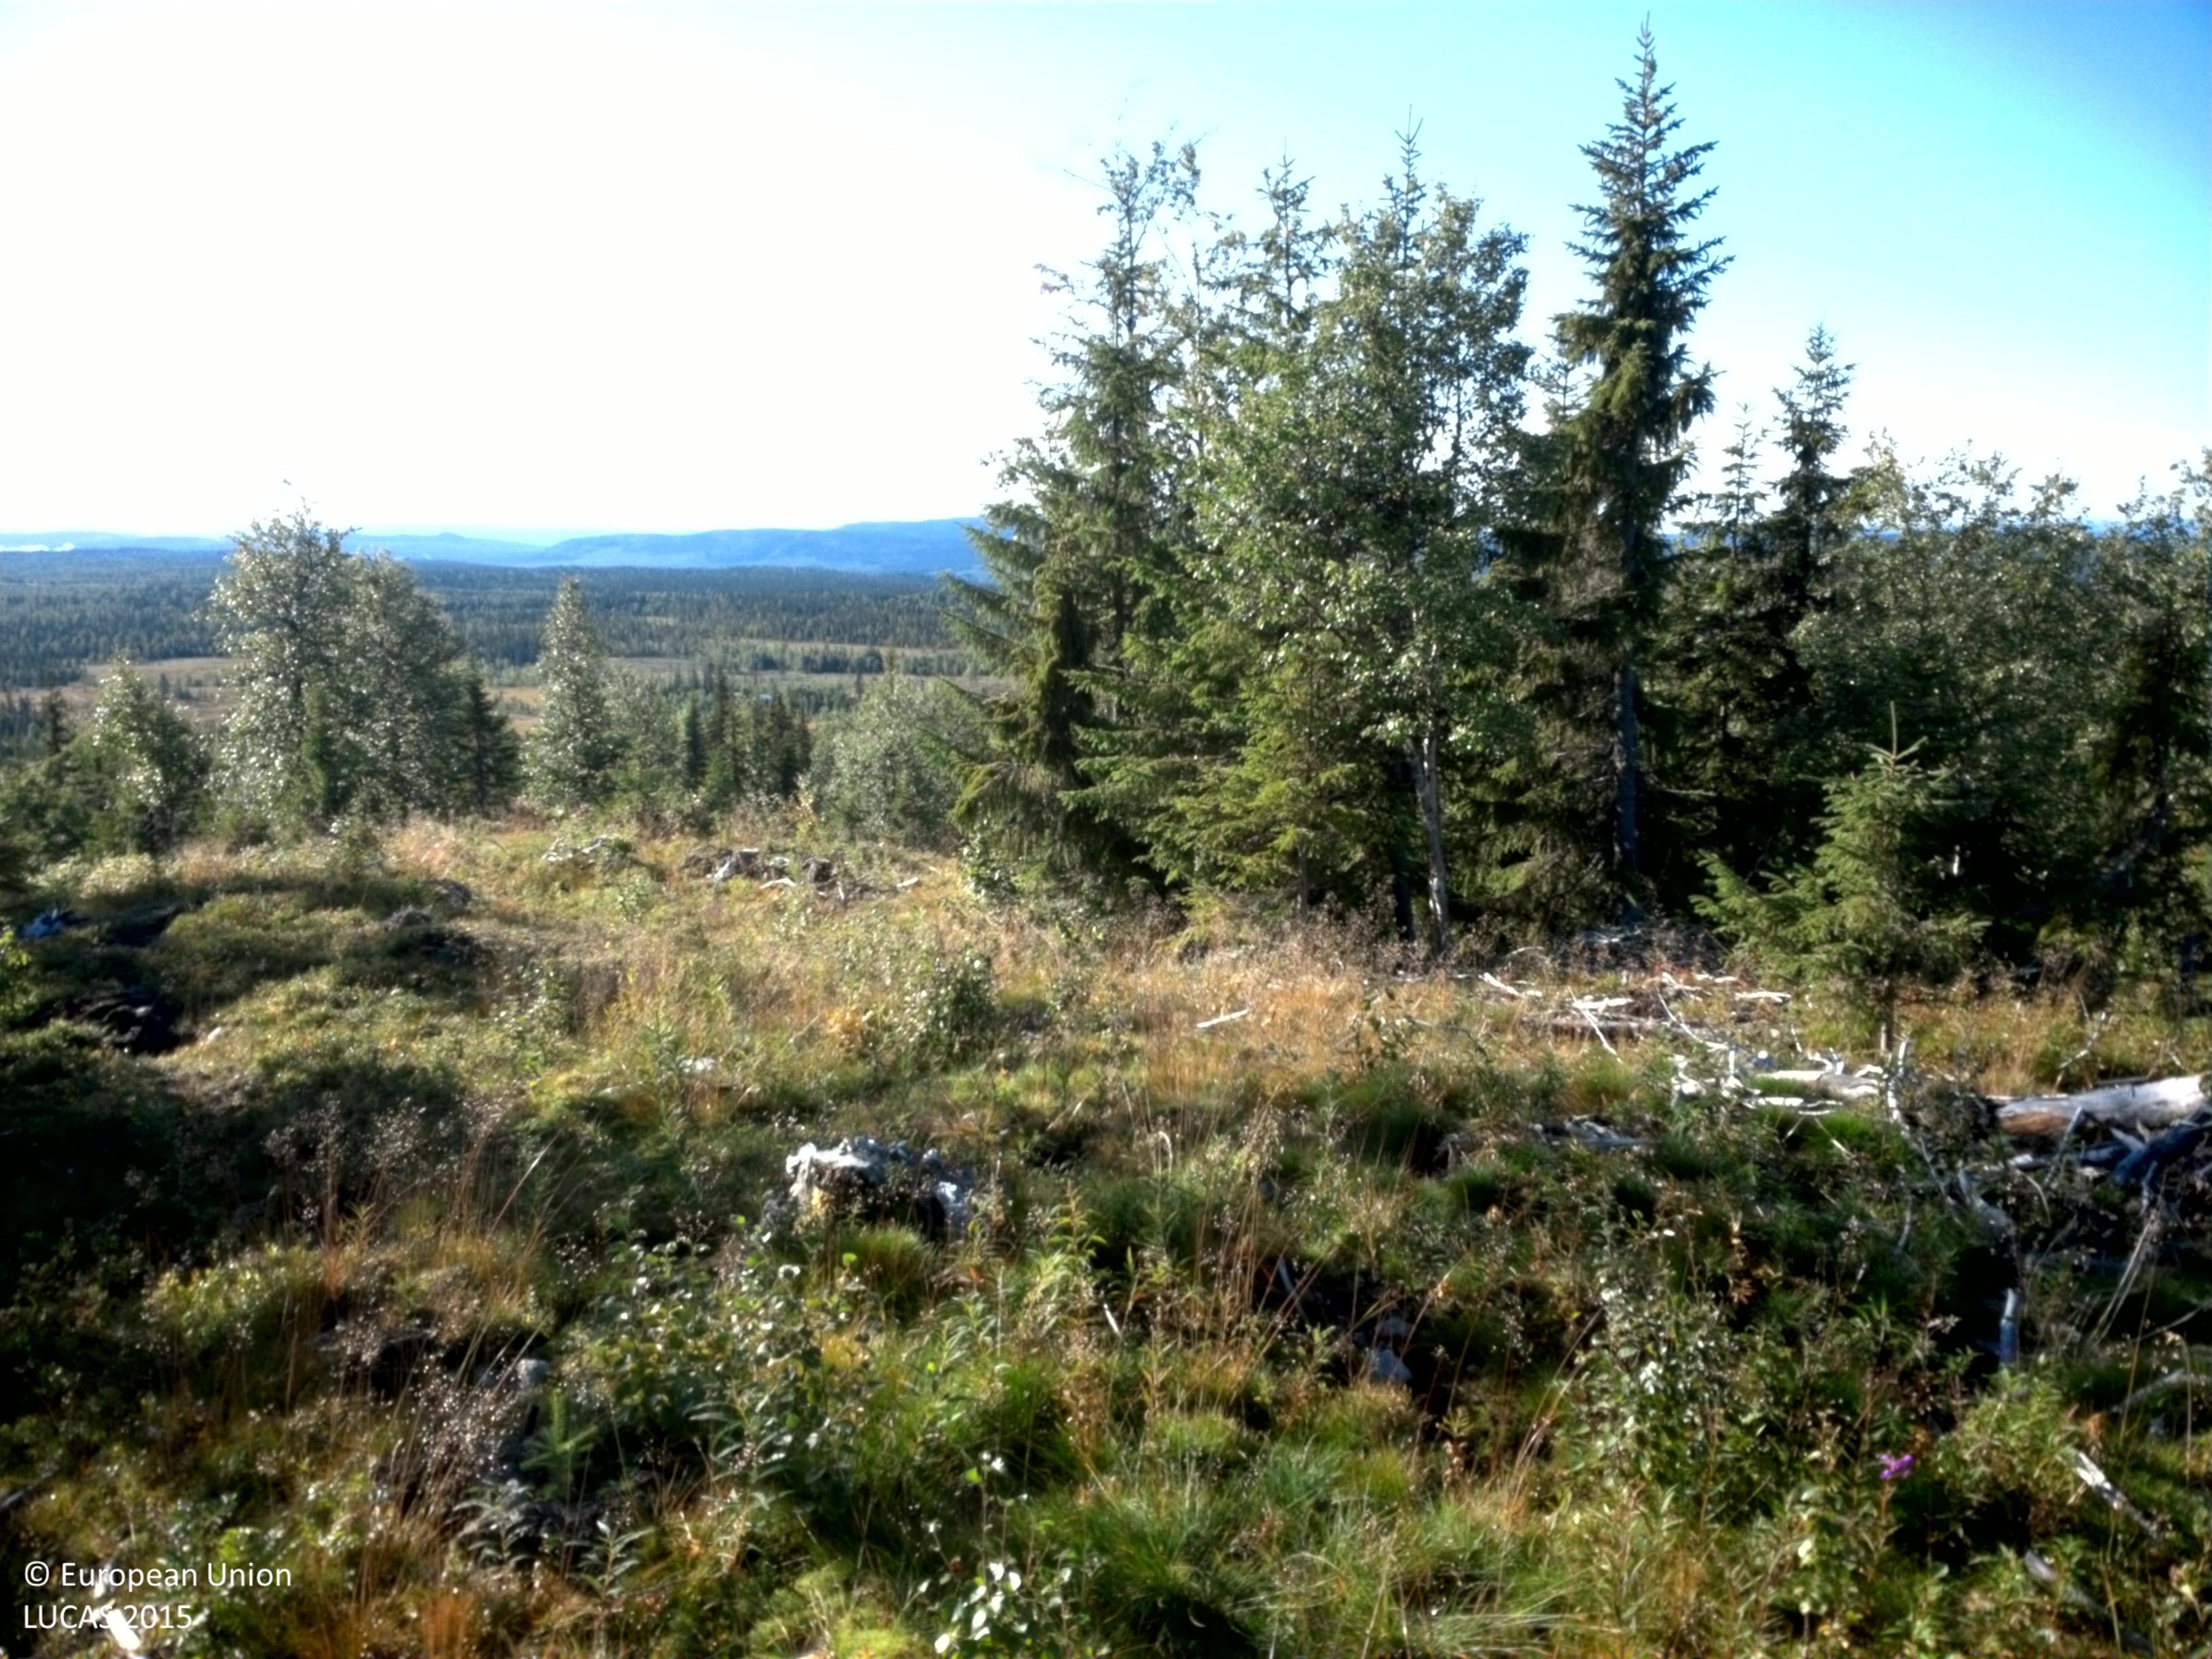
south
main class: Shrubland
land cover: Shrubland with sparse tree cover
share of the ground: 10 - 25 %
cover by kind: herbaceous plants 65 %, shrubs 20 %, broadleaved forest trees 5 %, lichens and mosses 5 %, unconsolidated bare surface 5 %
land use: Forestry
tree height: < 5 m
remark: Clear cut
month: September
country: SE
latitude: 65.2216
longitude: 16.1441
